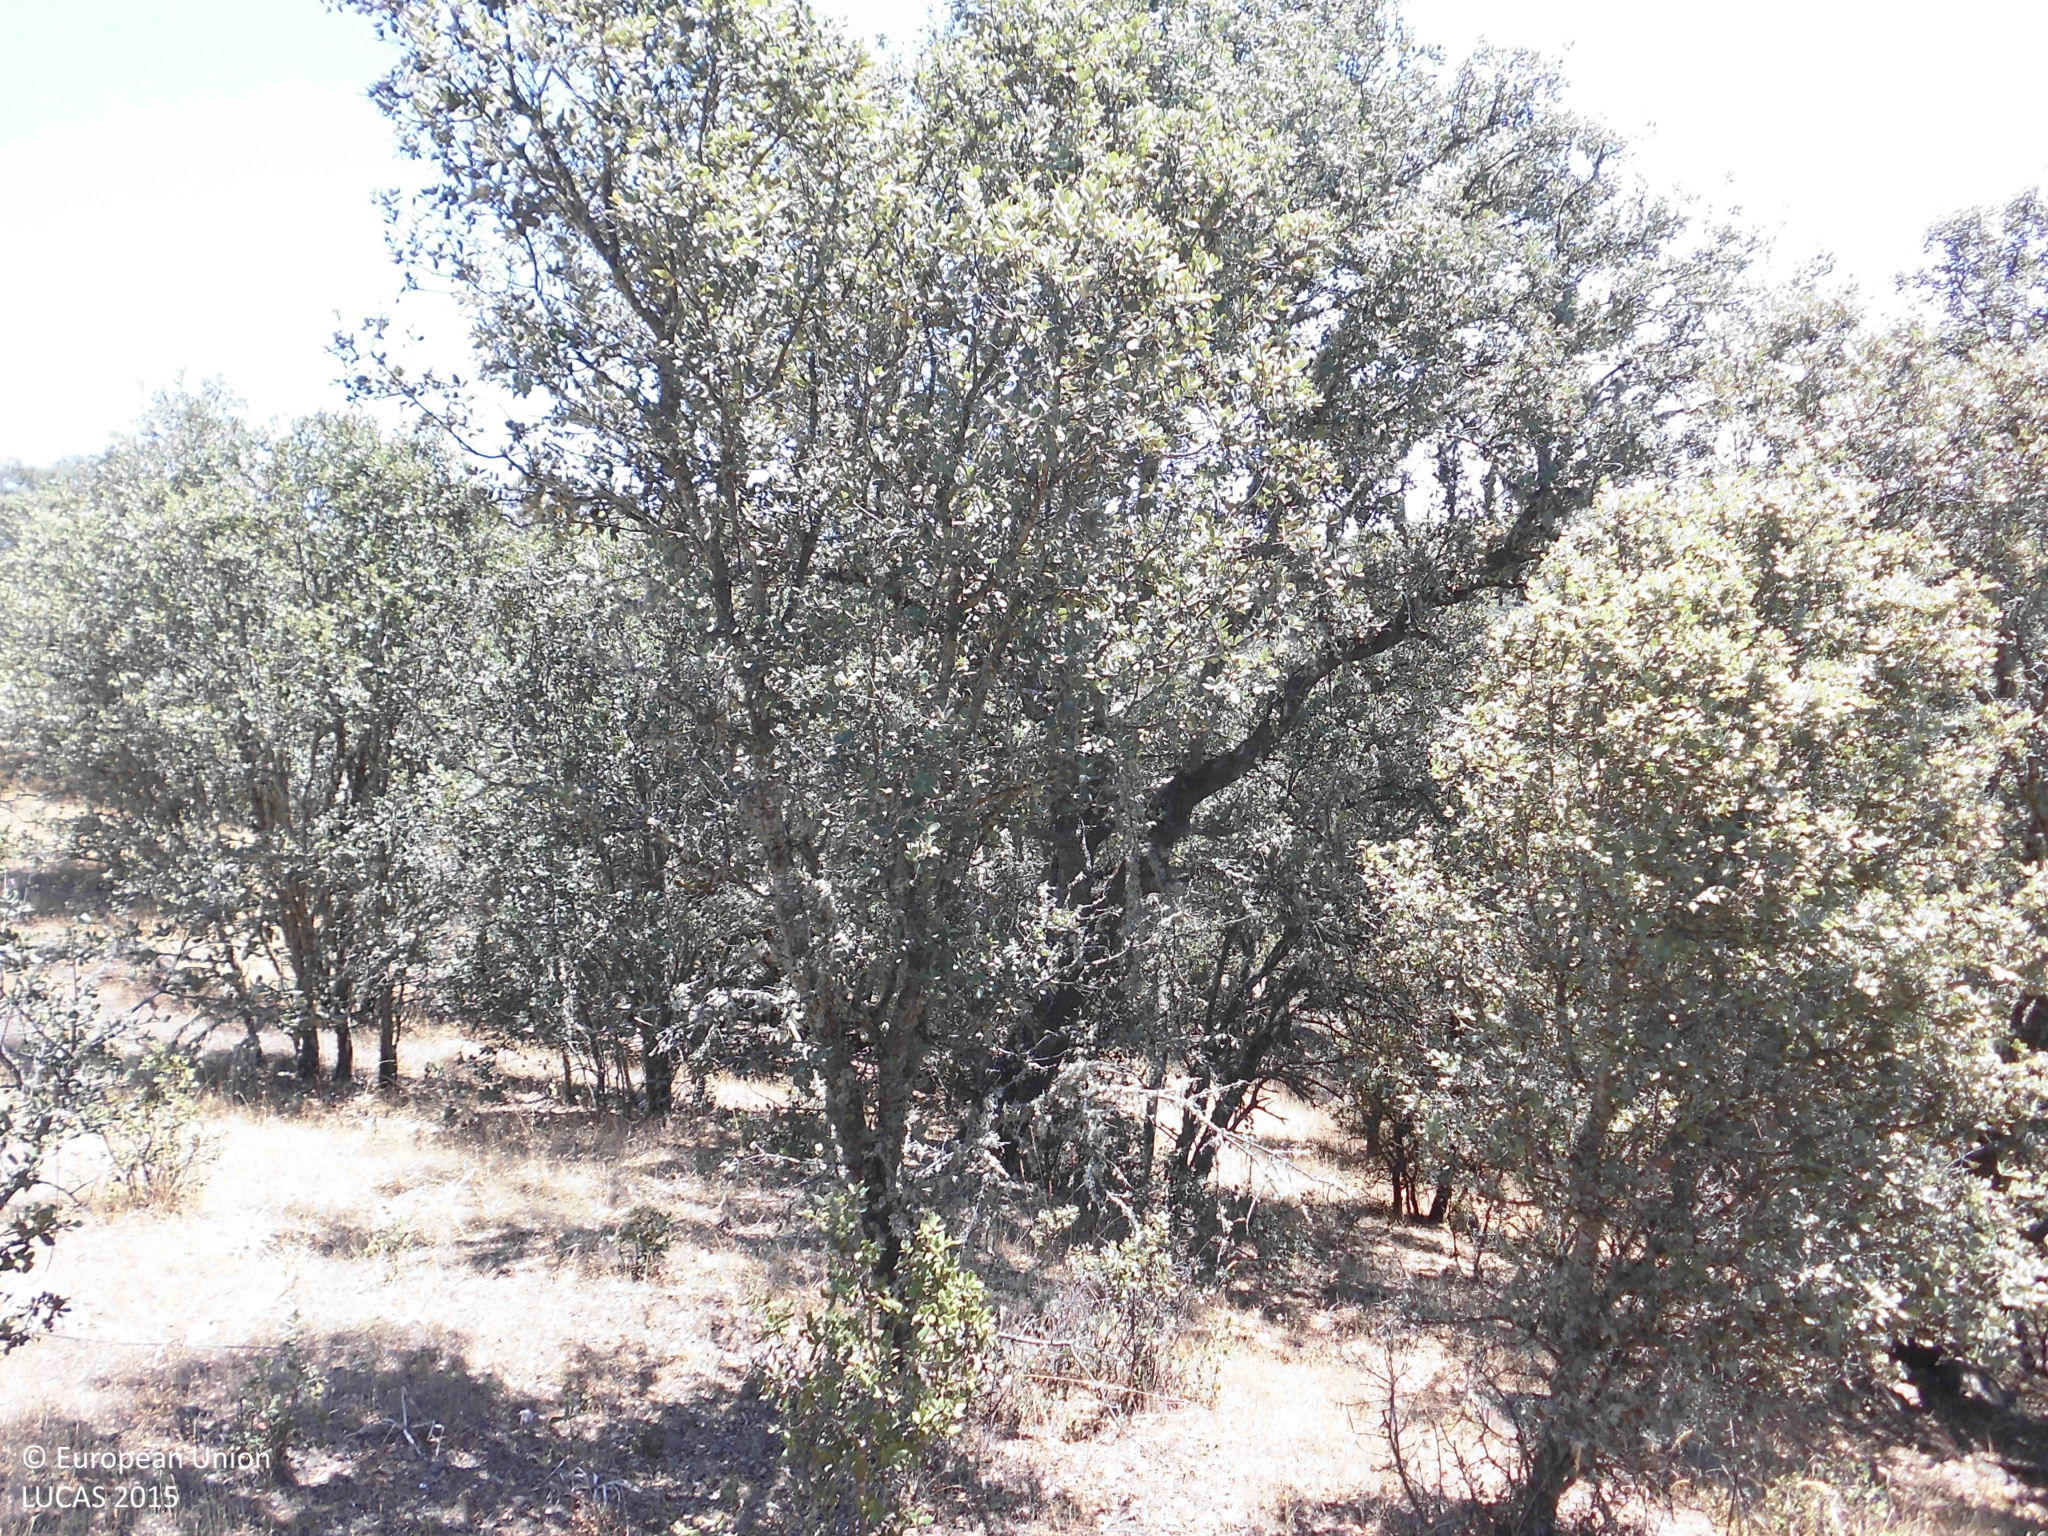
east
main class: Woodland
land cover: Broadleaved woodland
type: broadleaved evergreen forest
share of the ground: 50 - 75 %
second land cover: Grassland without tree/shrub cover
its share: > 75 %
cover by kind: broadleaved forest trees 50 %, herbaceous plants 50 %
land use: Semi-natural and natural areas not in use
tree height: > 5 m
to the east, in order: Broadleaved woodland; Grassland without tree/shrub cover; Broadleaved woodland
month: June
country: ES
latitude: 39.6551
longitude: -6.0433
